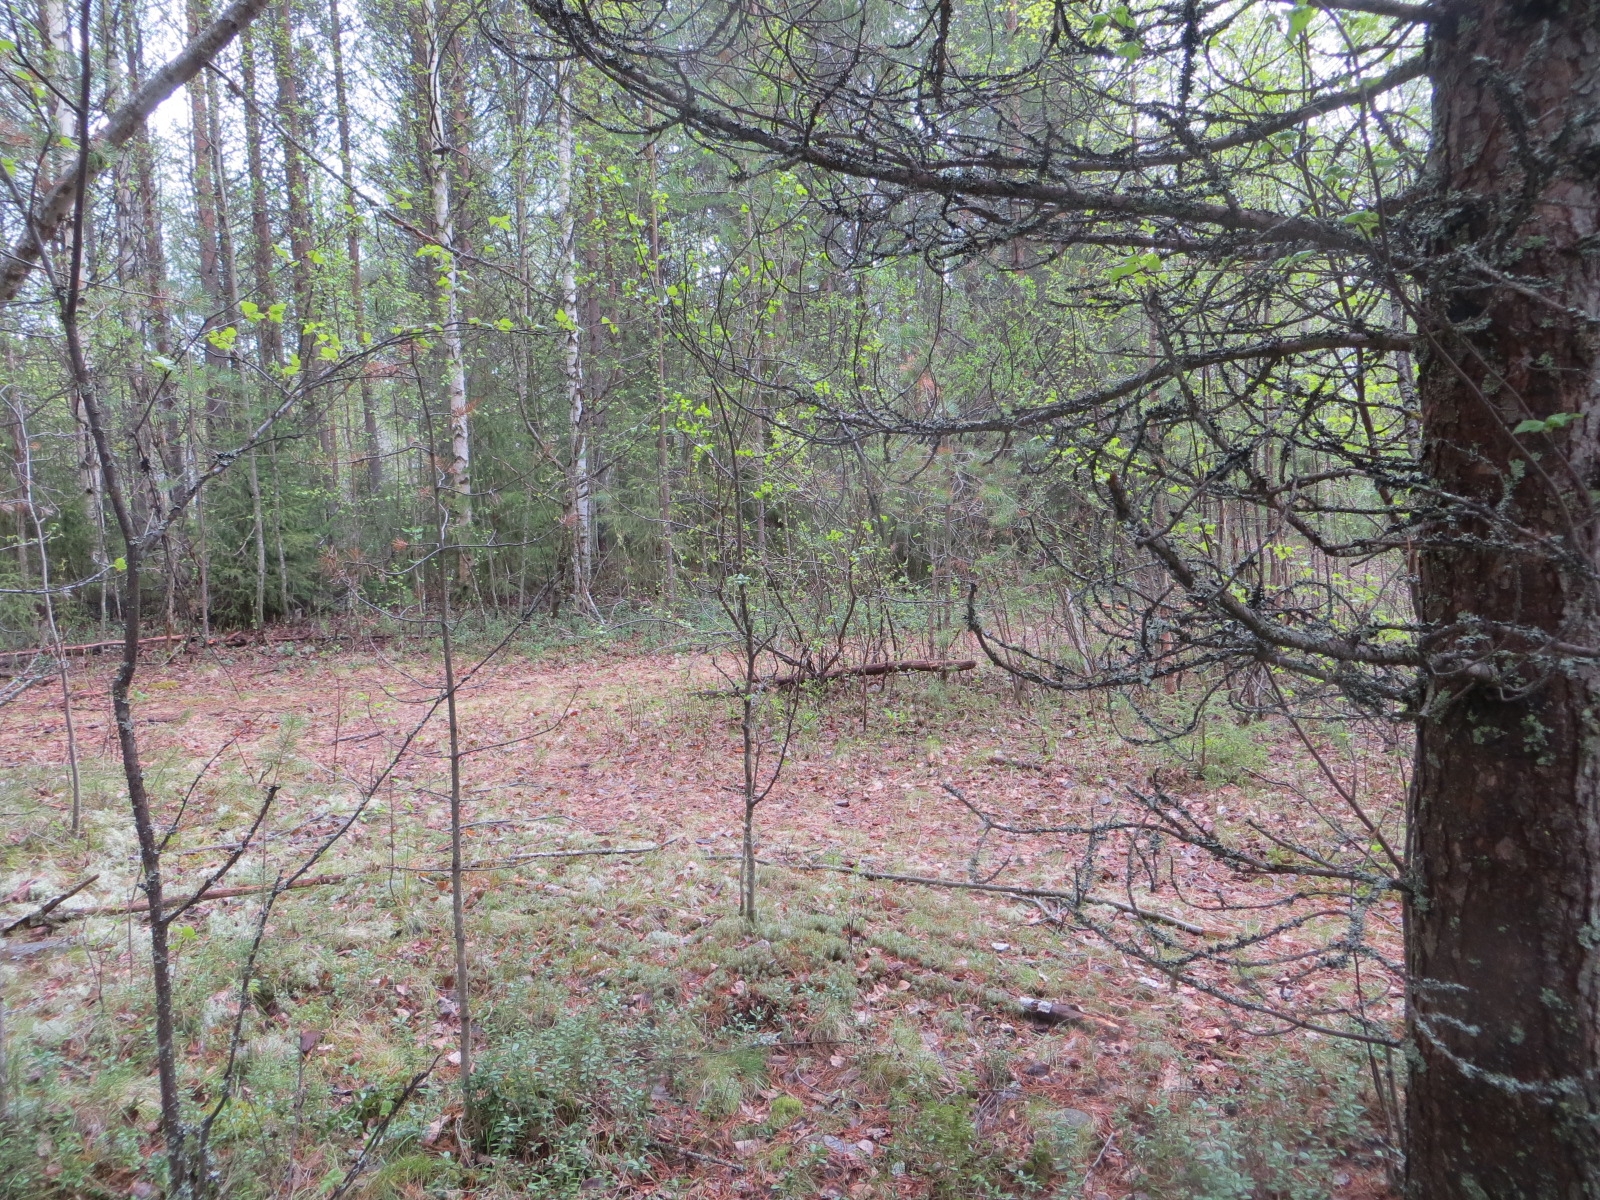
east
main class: Woodland
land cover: Other mixed woodland
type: boreal forest
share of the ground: > 75 %
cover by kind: coniferous forest trees 45 %, broadleaved forest trees 45 %, shrubs 10 %
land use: Forestry
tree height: > 5 m
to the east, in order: Other mixed woodland; Pine dominated mixed woodland; Tracks; Pine dominated coniferous woodland; Broadleaved woodland; Tracks; Grassland without tree/shrub cover; Railways; Electric lines; Grassland with sparse tree/shrub cover; Ponds and wetlands; Pine dominated mixed woodland; Ponds and wetlands; Pine dominated mixed woodland; Grassland without tree/shrub cover; Pine dominated mixed woodland
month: June
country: FI
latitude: 66.5231
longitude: 25.8398
